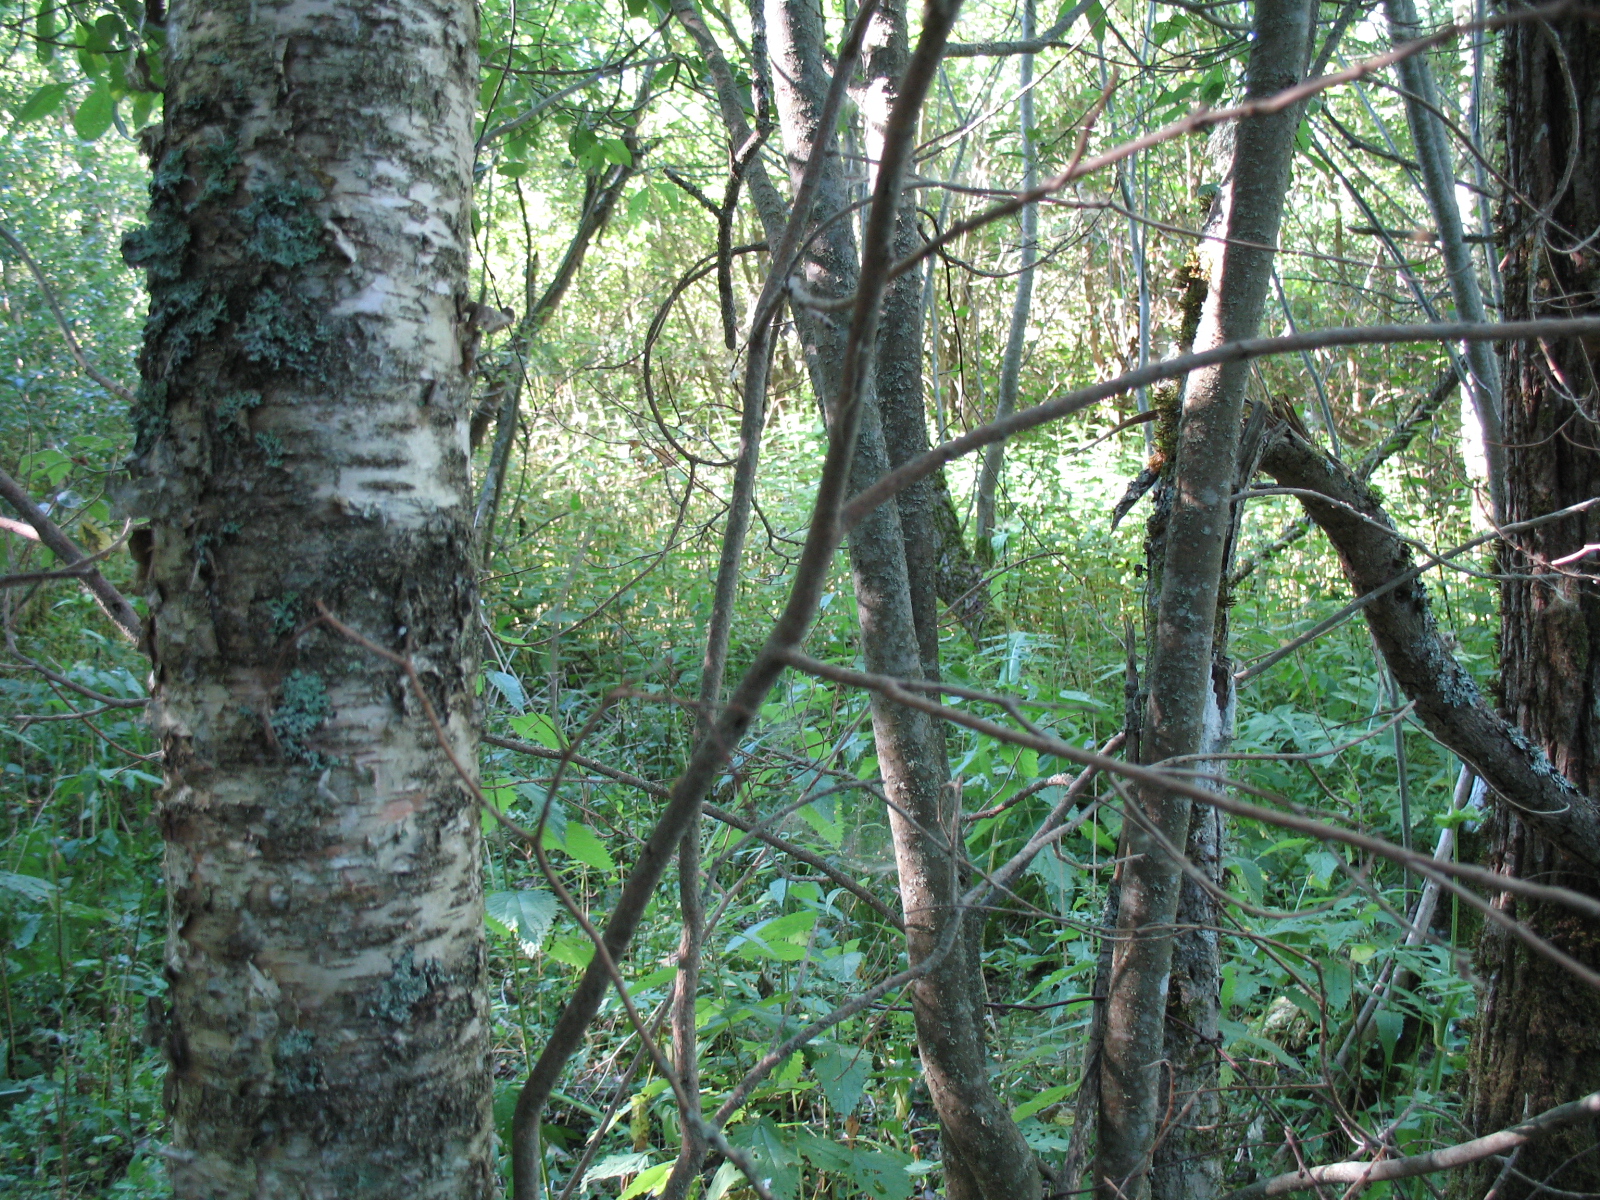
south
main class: Woodland
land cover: Broadleaved woodland
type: non-riverine alder, birch or aspen forest
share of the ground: 50 - 75 %
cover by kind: broadleaved forest trees 65 %, herbaceous plants 25 %, shrubs 10 %
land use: Forestry
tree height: > 5 m
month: August
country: LV
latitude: 56.4352
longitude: 25.6112
